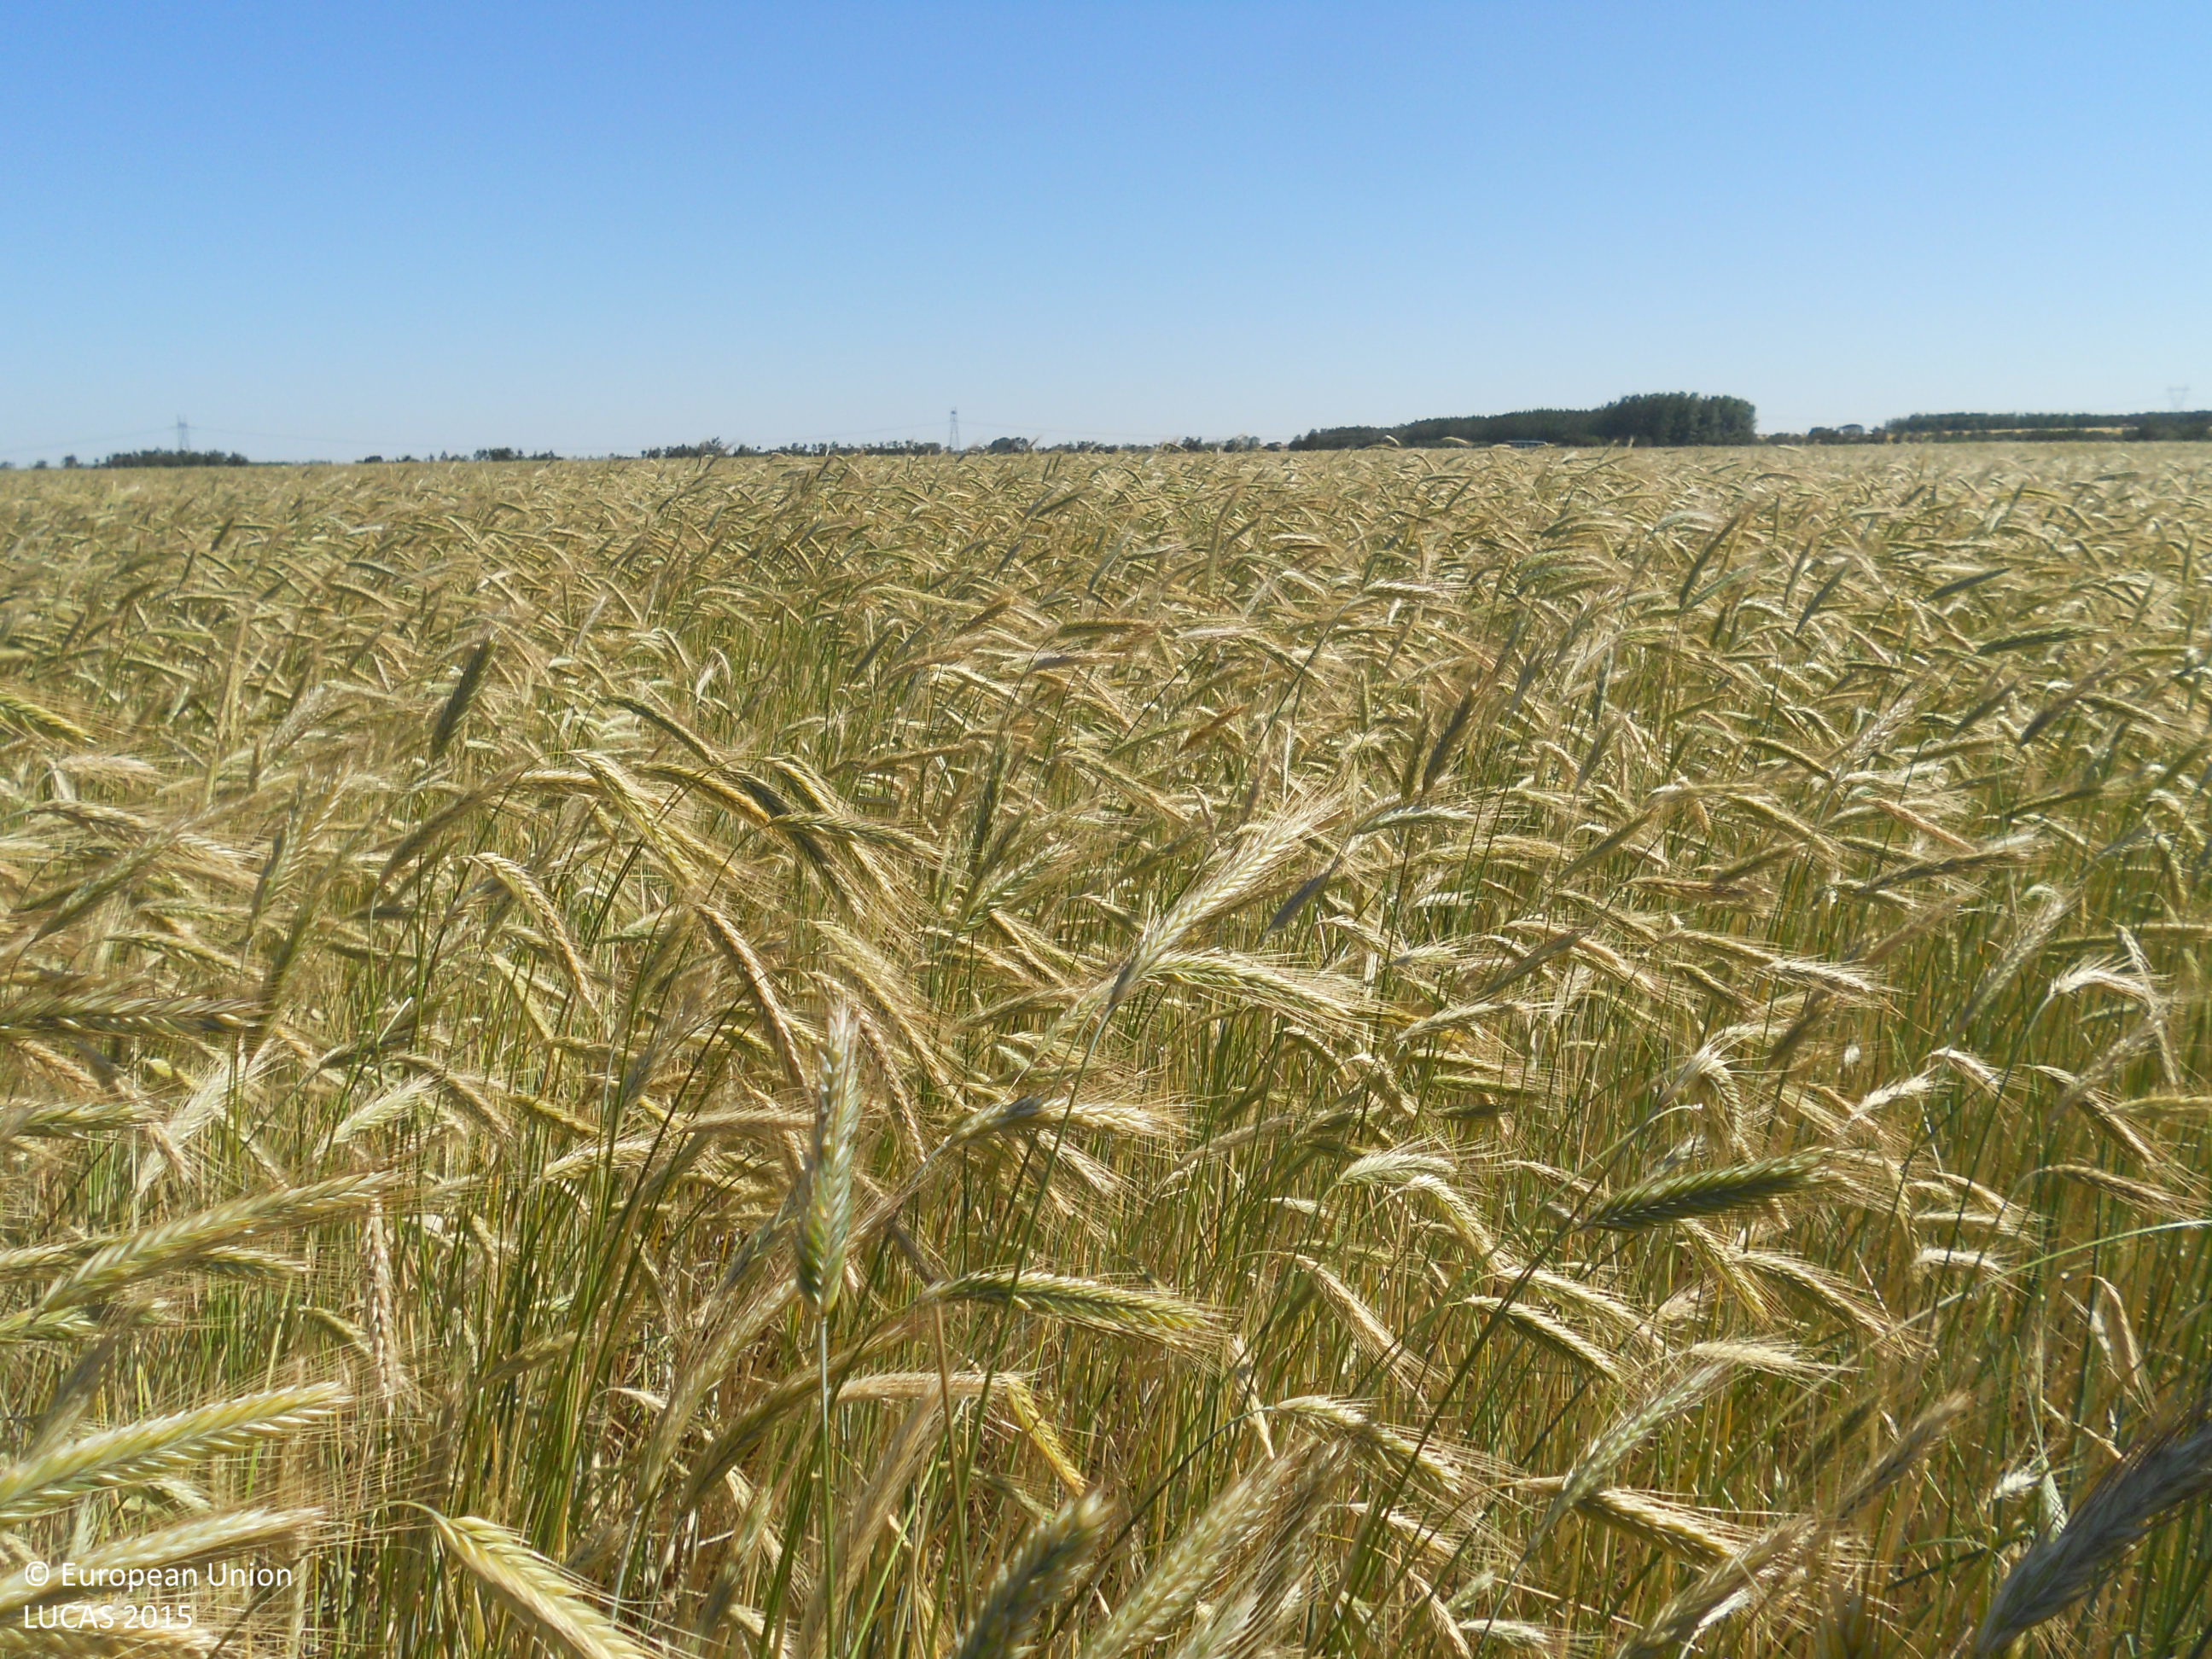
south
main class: Cropland
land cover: Rye
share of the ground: > 75 %
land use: Agriculture (excluding fallow land and kitchen gardens)
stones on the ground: > 50 %
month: June
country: ES
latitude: 42.4535
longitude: -4.8303
